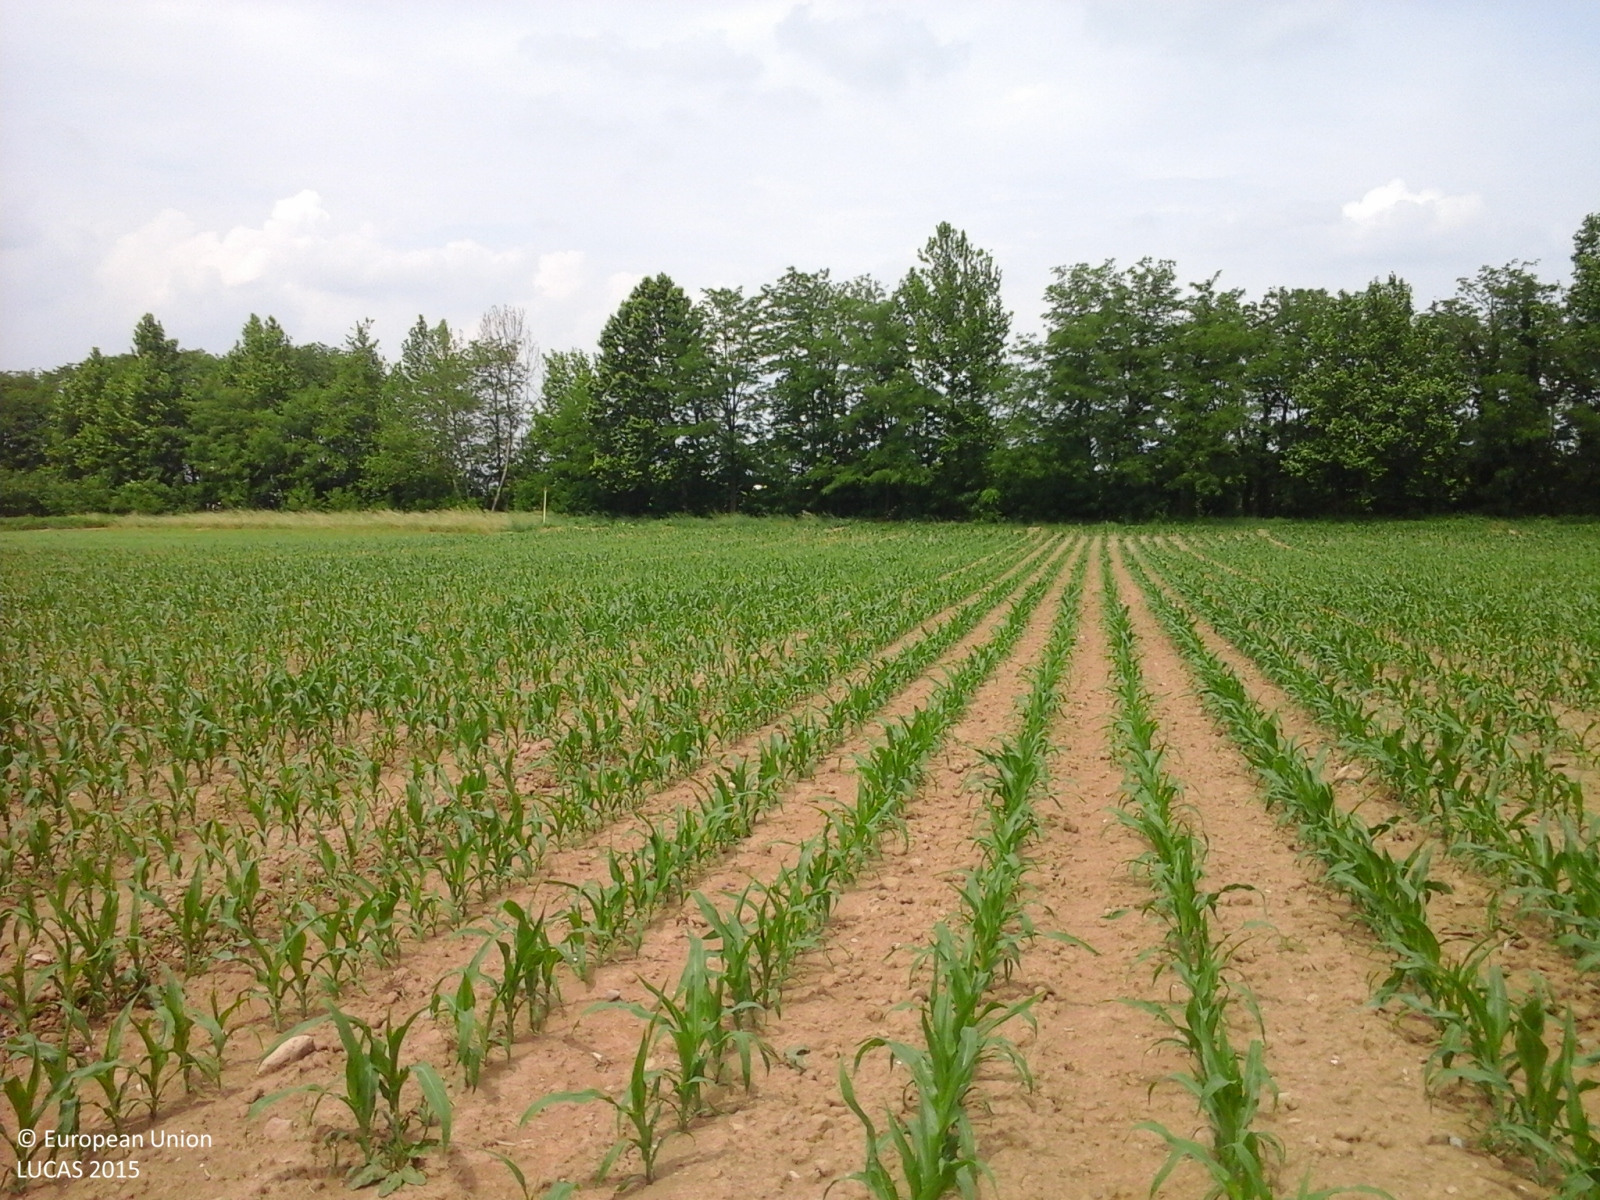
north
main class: Cropland
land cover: Maize
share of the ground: < 10 %
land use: Agriculture (excluding fallow land and kitchen gardens)
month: May
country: IT
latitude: 45.5578
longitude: 9.6291
